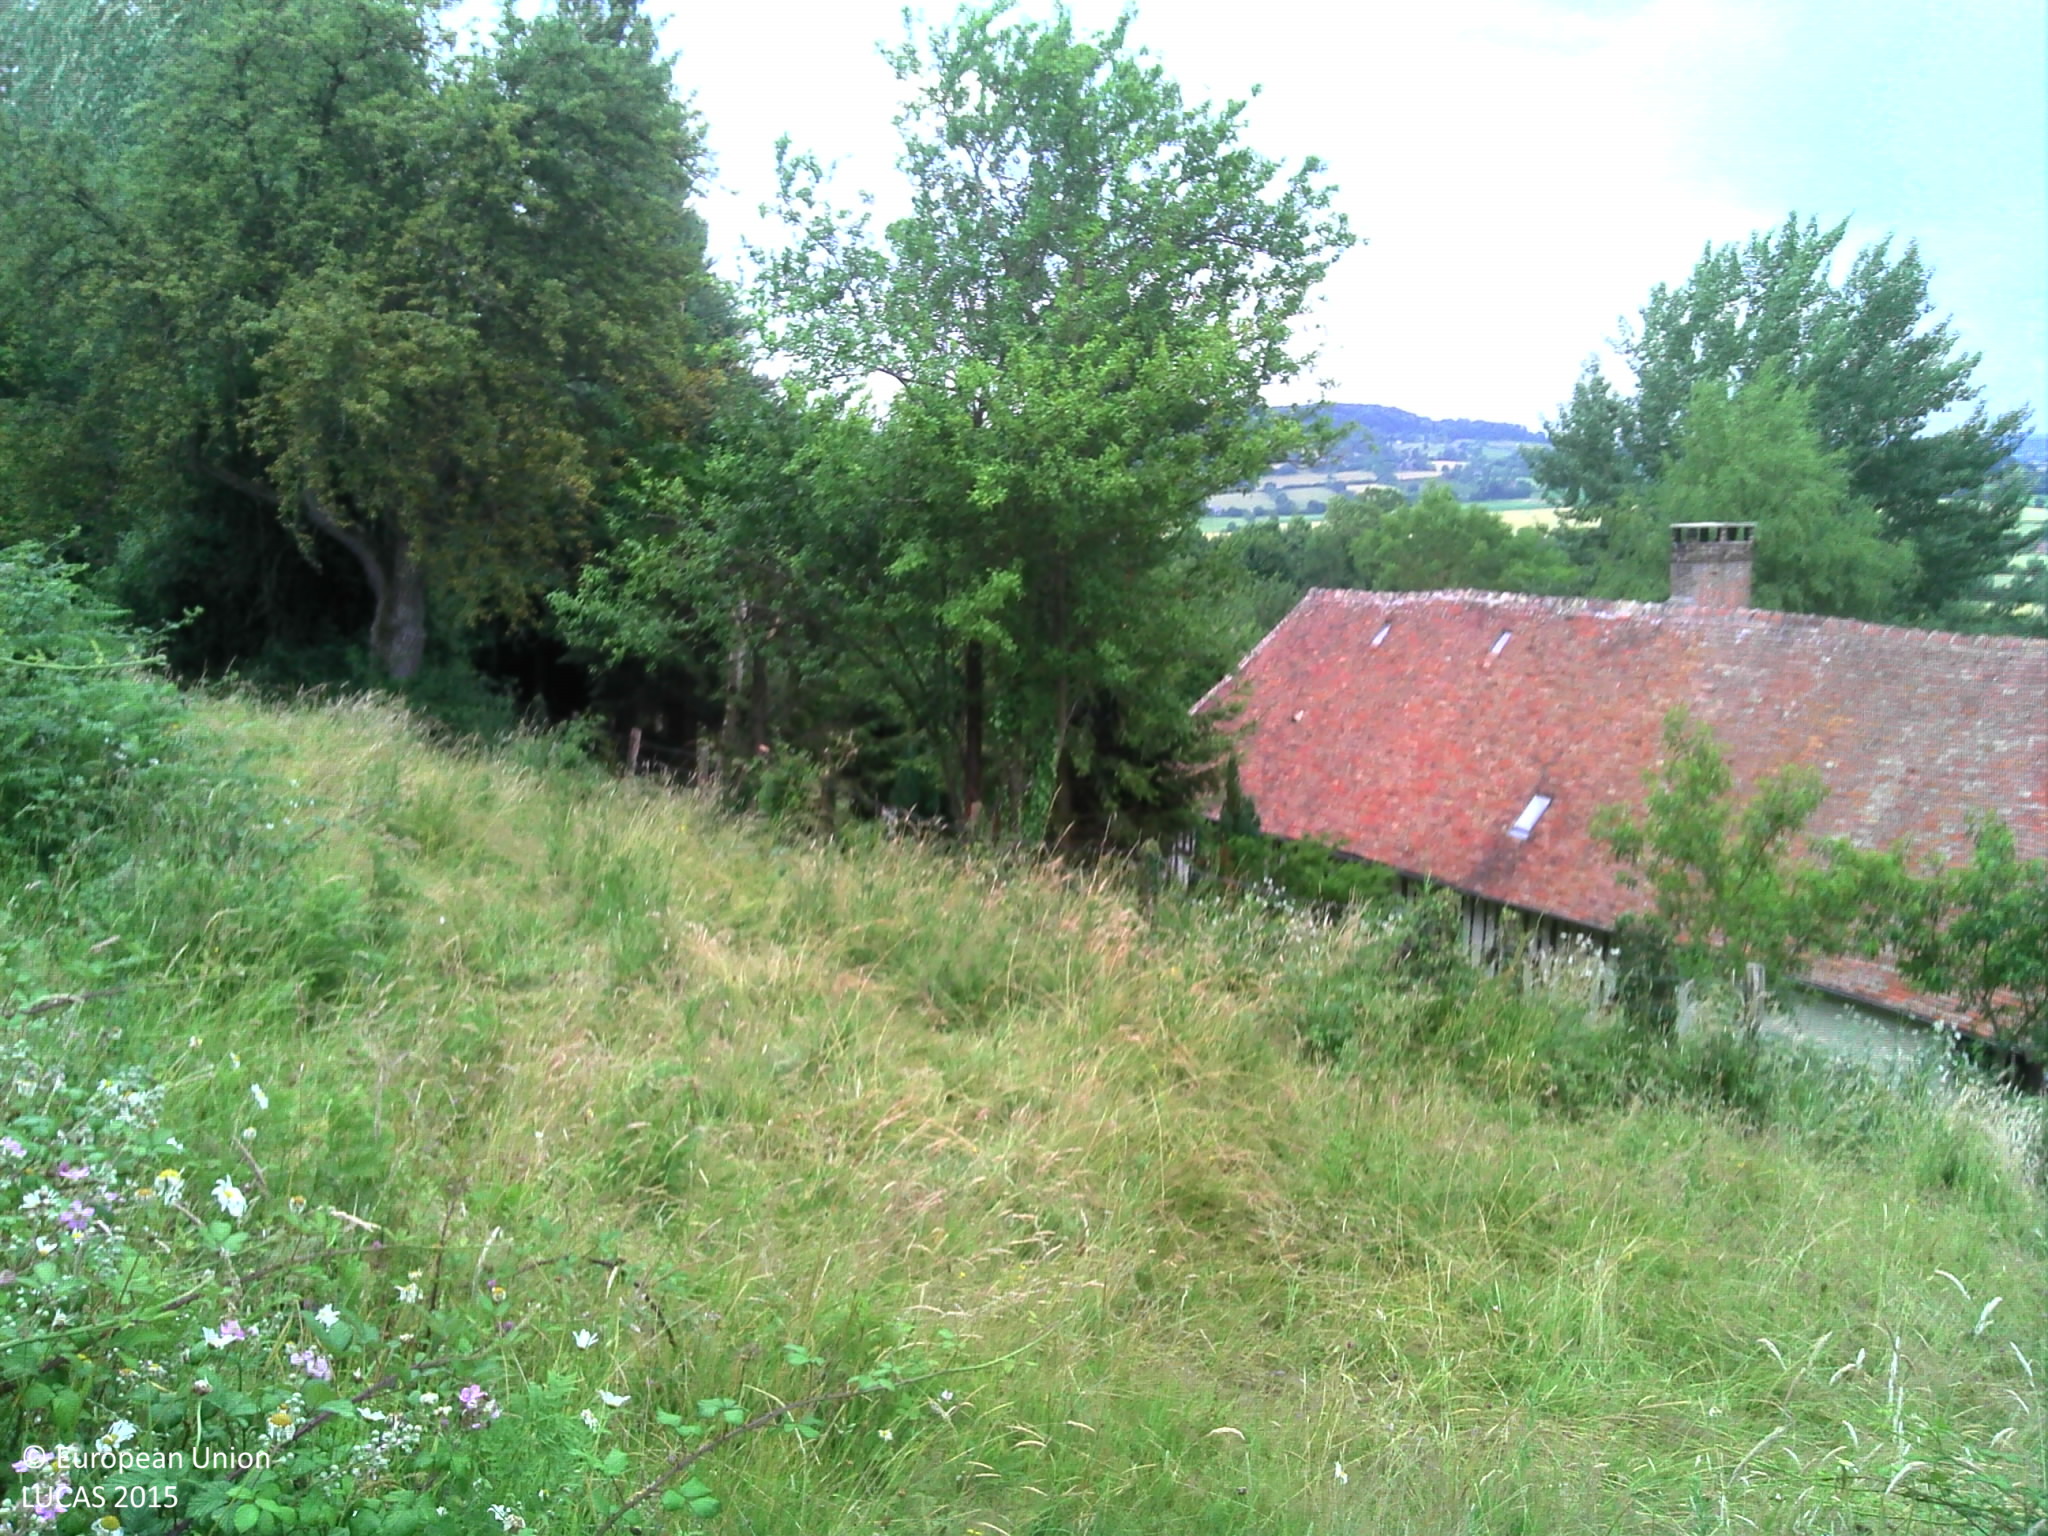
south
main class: Grassland
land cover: Spontaneously vegetated surfaces
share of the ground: > 75 %
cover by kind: herbaceous plants 95 %, shrubs 5 %
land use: Agriculture (excluding fallow land and kitchen gardens)
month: July
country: FR
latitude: 48.9701
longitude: 0.0660
